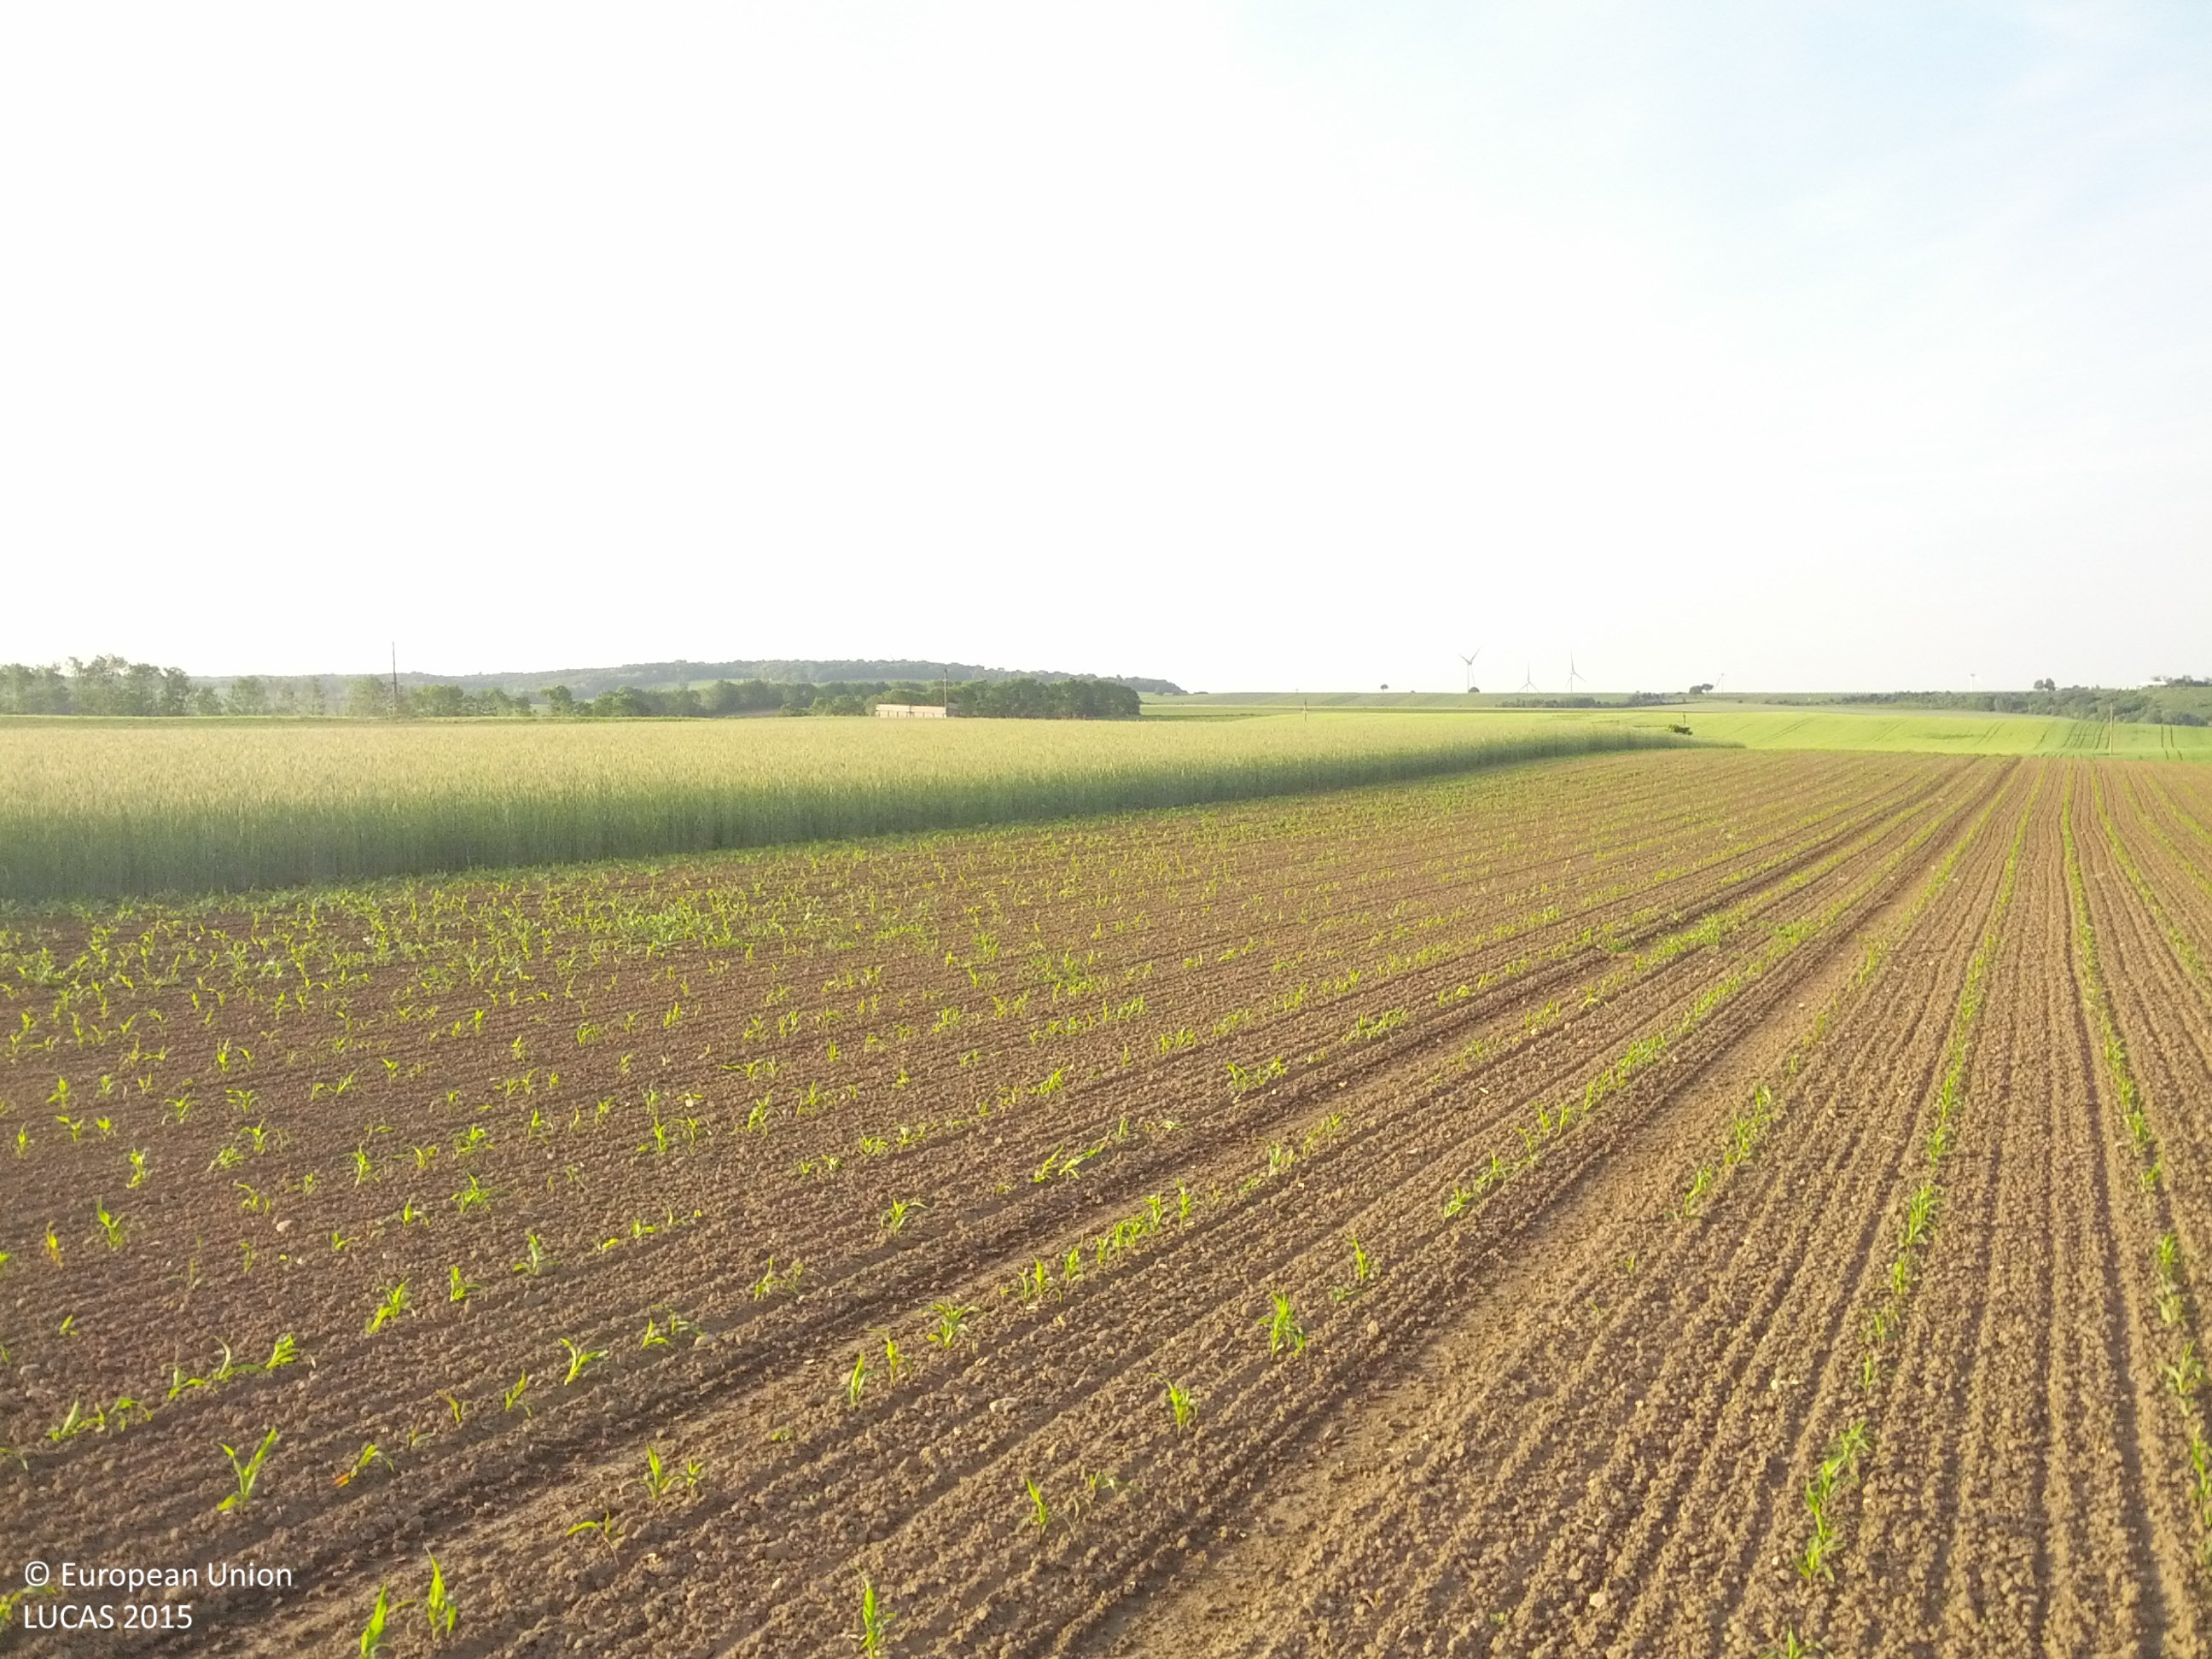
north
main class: Cropland
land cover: Maize
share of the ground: < 10 %
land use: Agriculture (excluding fallow land and kitchen gardens)
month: May
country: AT
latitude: 48.0524
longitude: 16.7545
